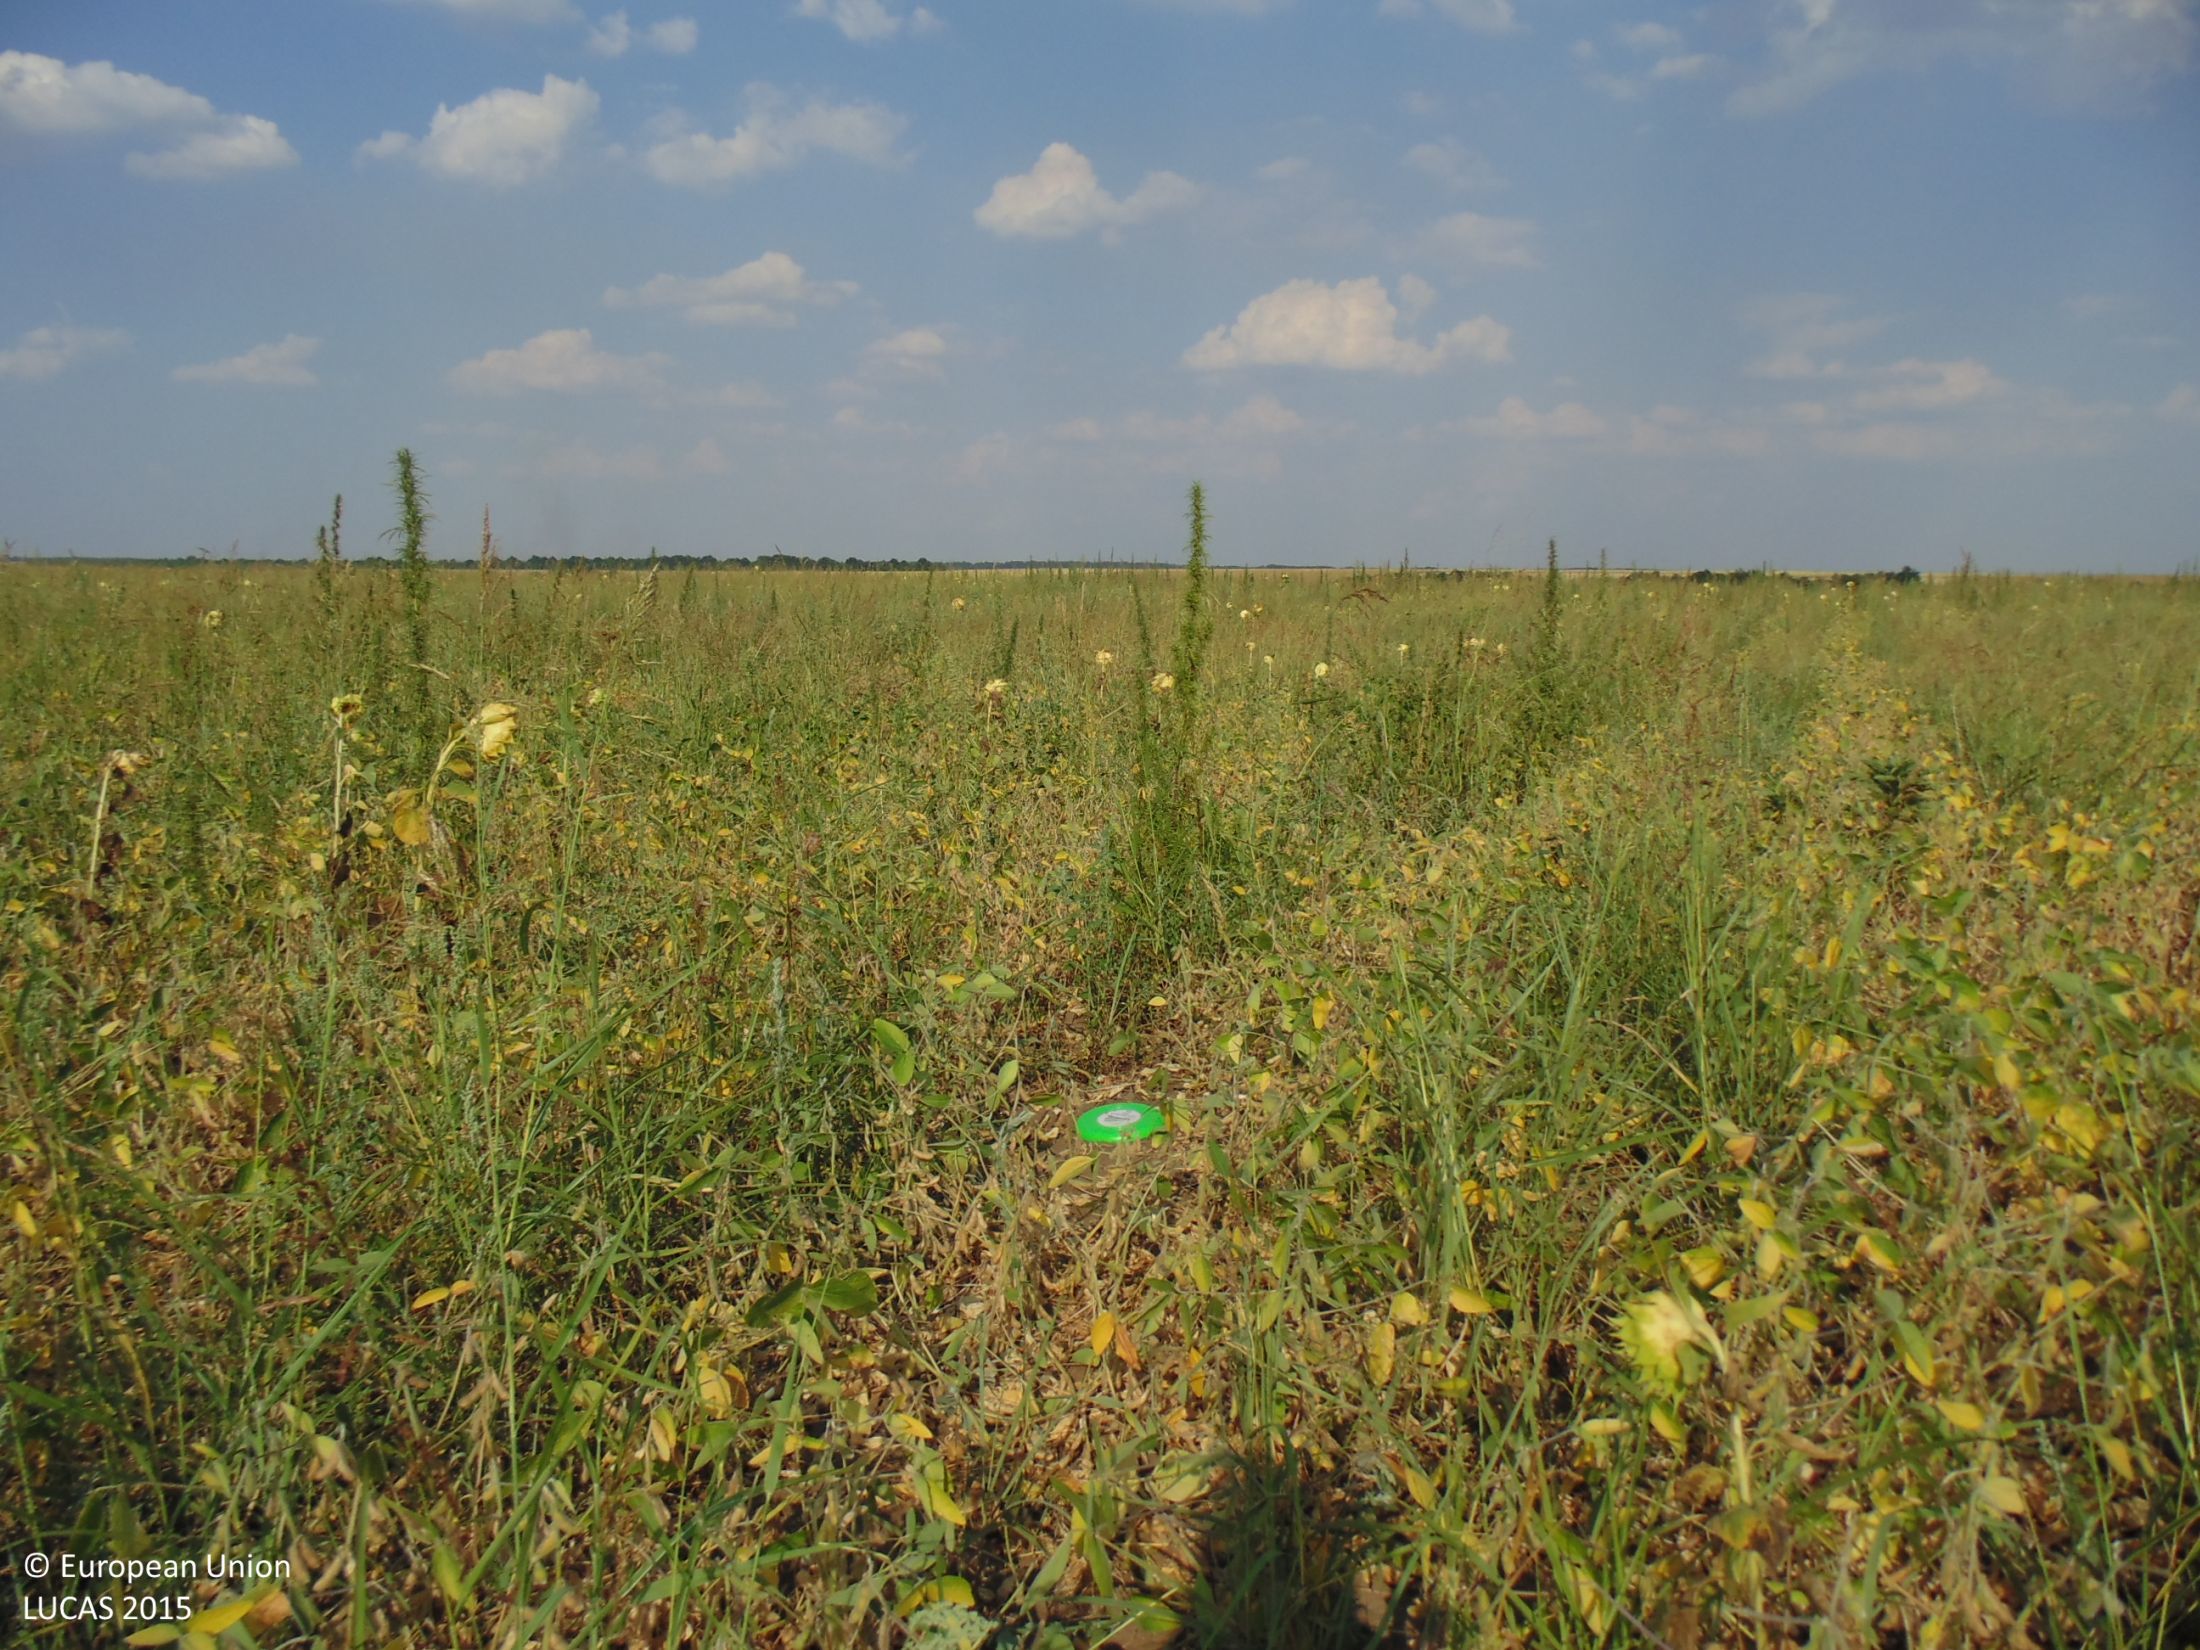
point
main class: Cropland
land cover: Soya
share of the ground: > 75 %
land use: Agriculture (excluding fallow land and kitchen gardens)
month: August
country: BG
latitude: 43.9120
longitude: 27.5332
